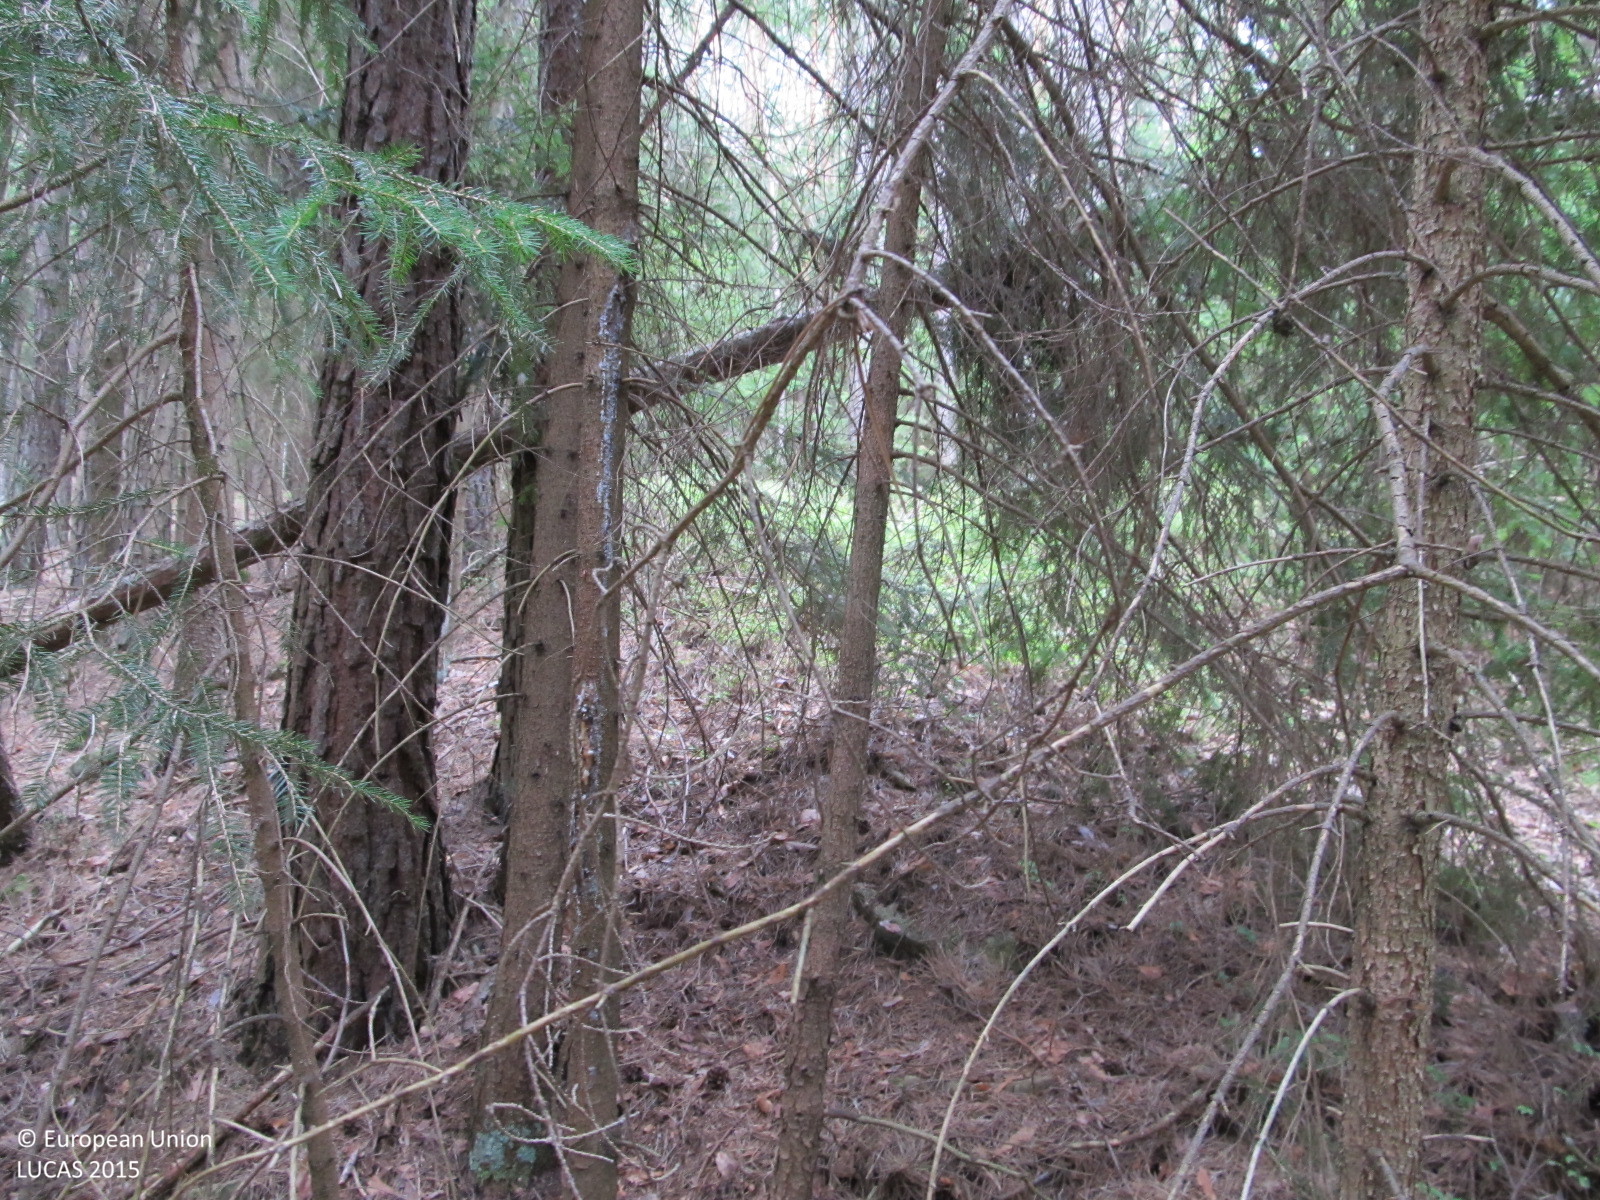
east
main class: Woodland
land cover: Other coniferous woodland
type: hemiboreal forest and nemoral coniferous forest and mixed broadleaved-coniferous forest
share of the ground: > 75 %
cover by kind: coniferous forest trees 80 %, lichens and mosses 10 %, herbaceous plants 5 %, unconsolidated bare surface 5 %
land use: Forestry
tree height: > 5 m
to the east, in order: Other coniferous woodland; Tracks; Other coniferous woodland; Grass margins; Common wheat; Grass margins; Tracks; Grass margins; Common wheat; Grass margins; Potatoes
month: July
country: AT
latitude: 48.5930
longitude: 15.0863
